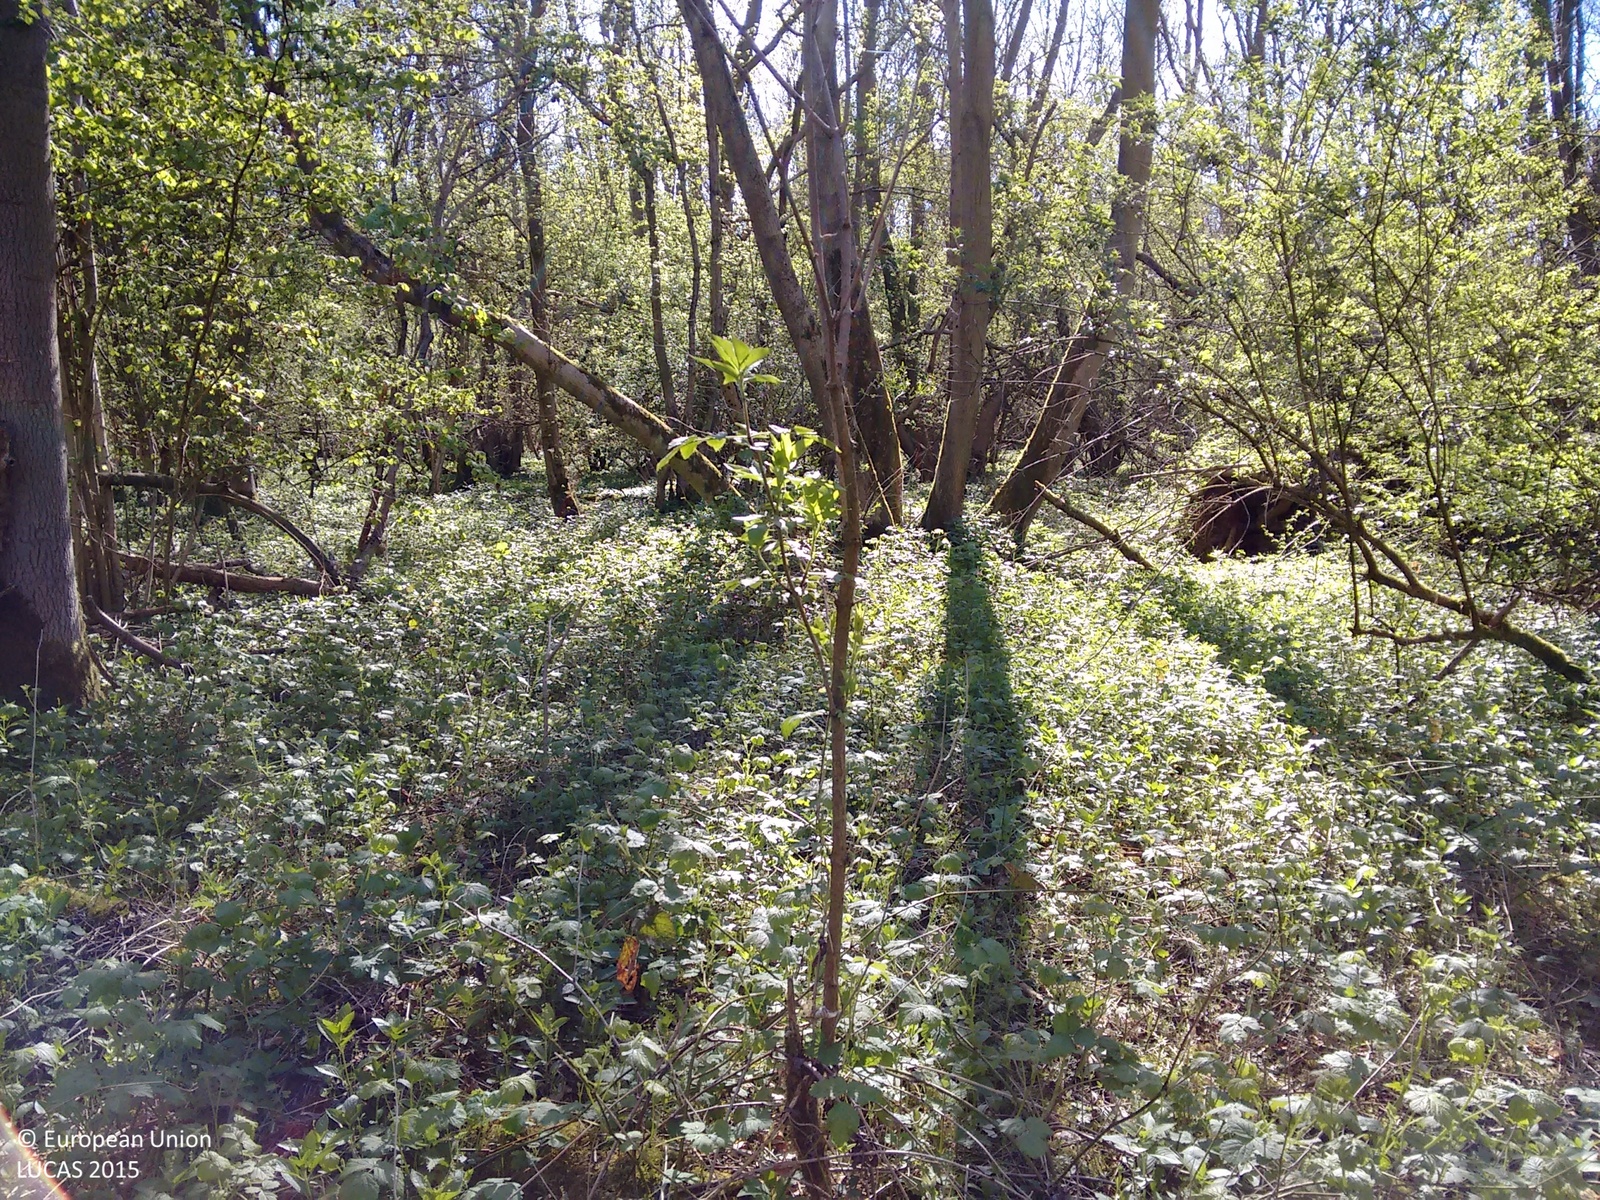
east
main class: Woodland
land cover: Broadleaved woodland
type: mesophytic deciduous forest
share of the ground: 50 - 75 %
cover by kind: broadleaved forest trees 100 %
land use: Forestry
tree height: > 5 m
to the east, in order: Broadleaved woodland; Tracks; Broadleaved woodland
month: April
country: GB
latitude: 53.3775
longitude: -0.7279
